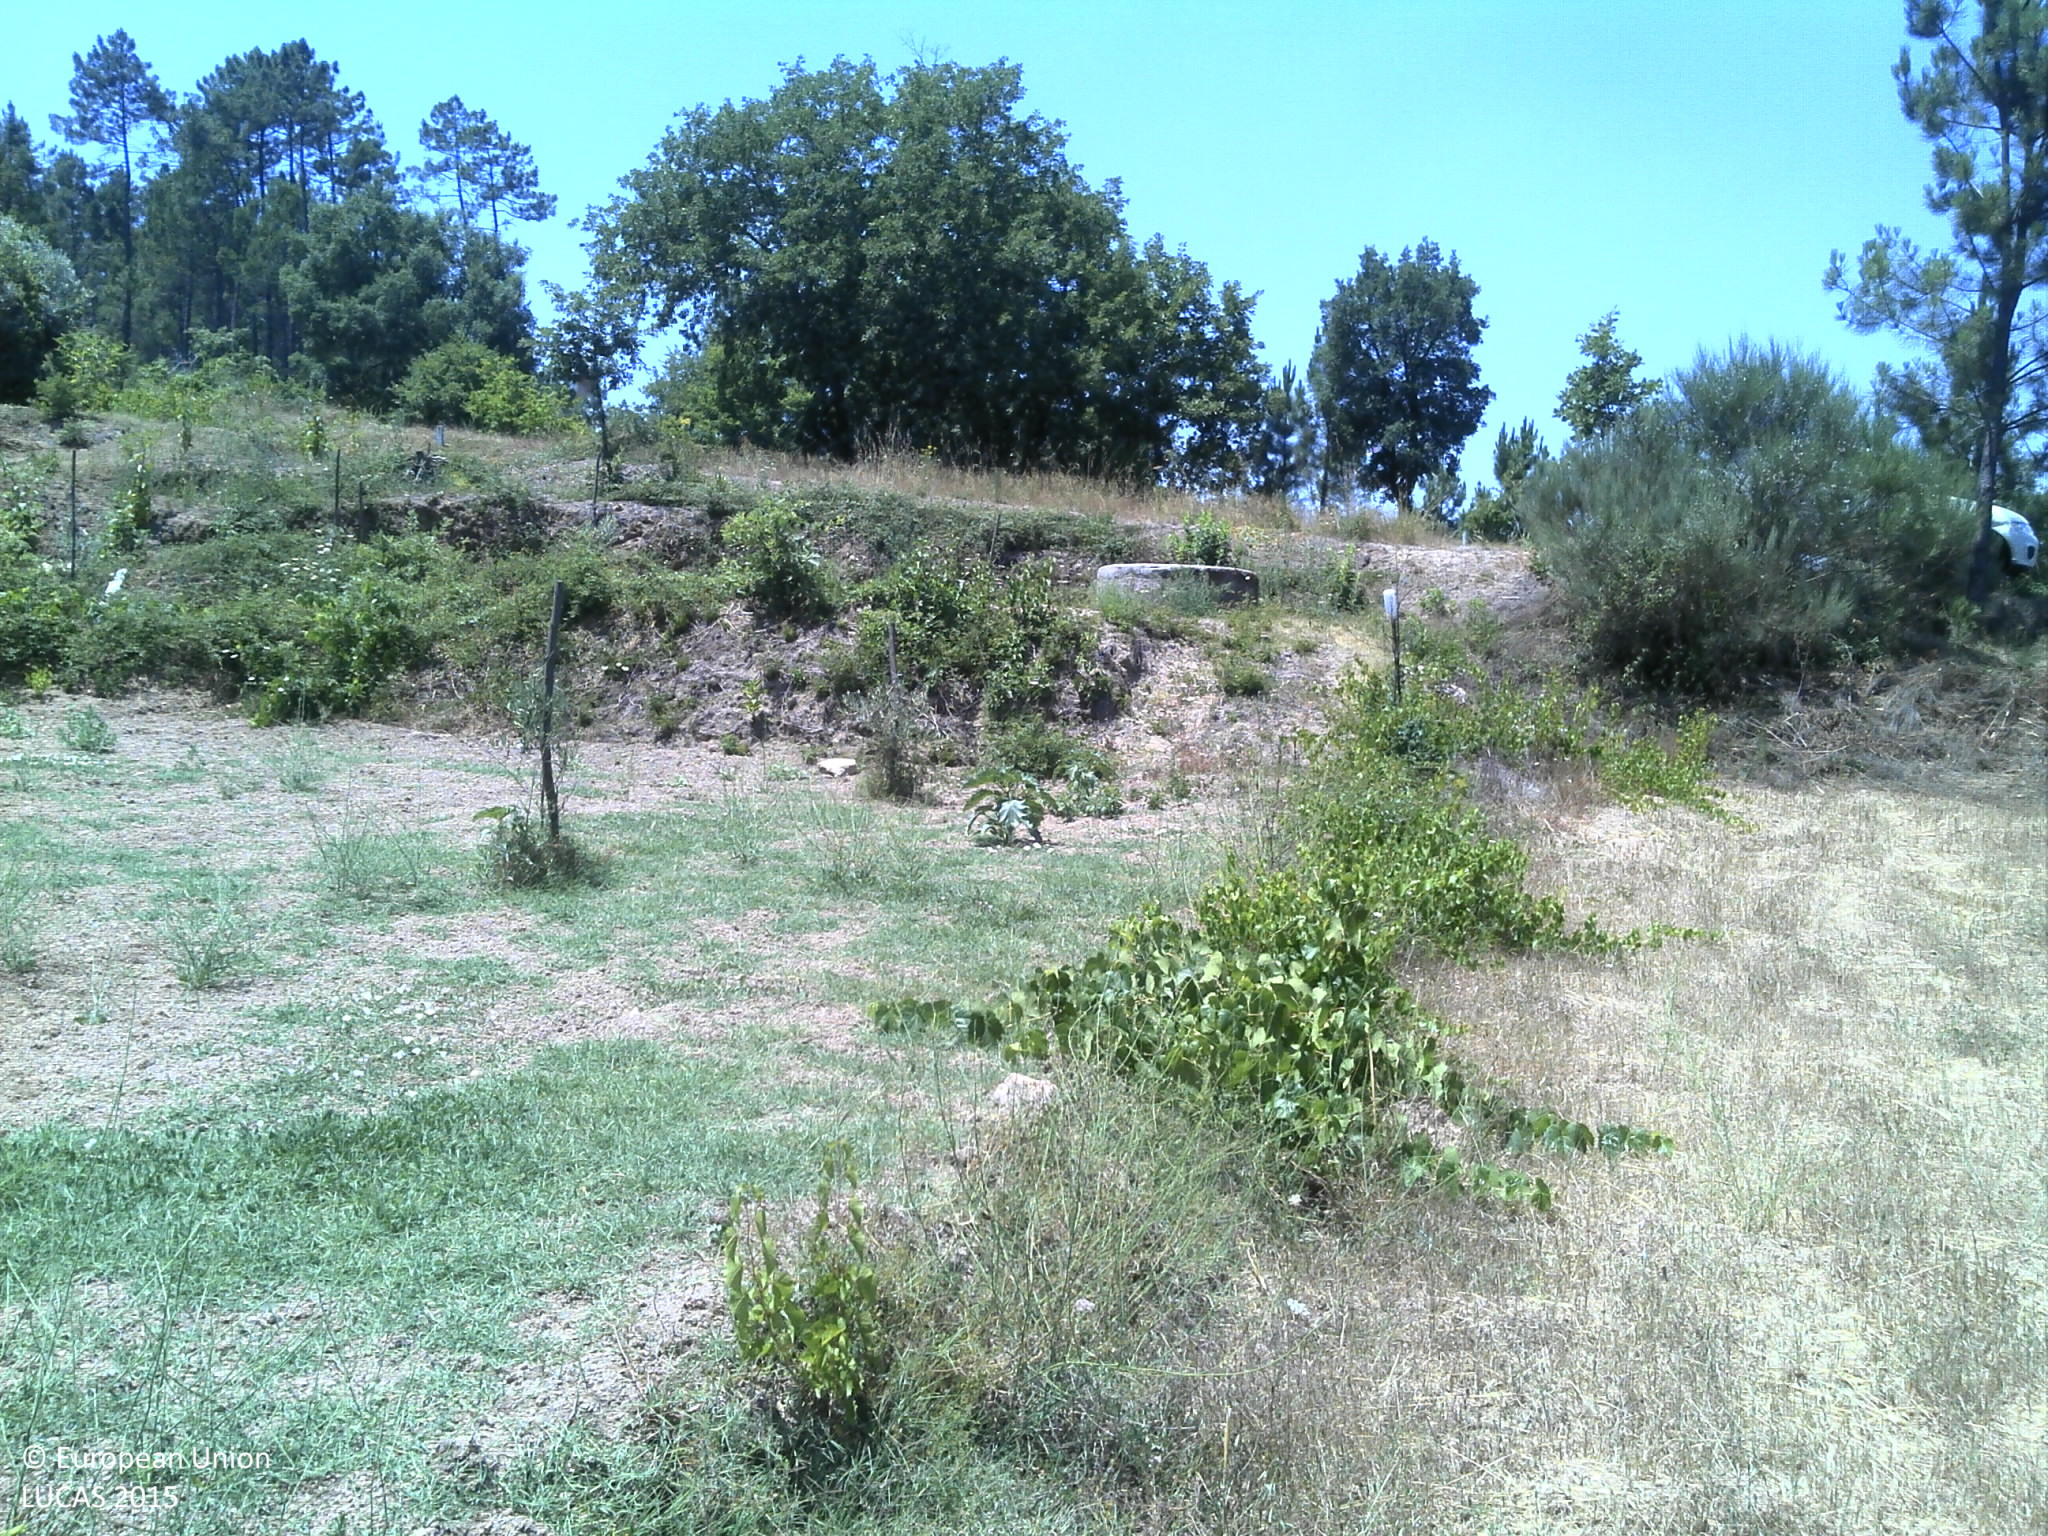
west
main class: Cropland
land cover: Other leguminous and mixtures for fodder
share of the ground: < 10 %
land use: Agriculture (excluding fallow land and kitchen gardens)
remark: Harvested field
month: July
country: PT
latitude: 40.3768
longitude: -8.0134
